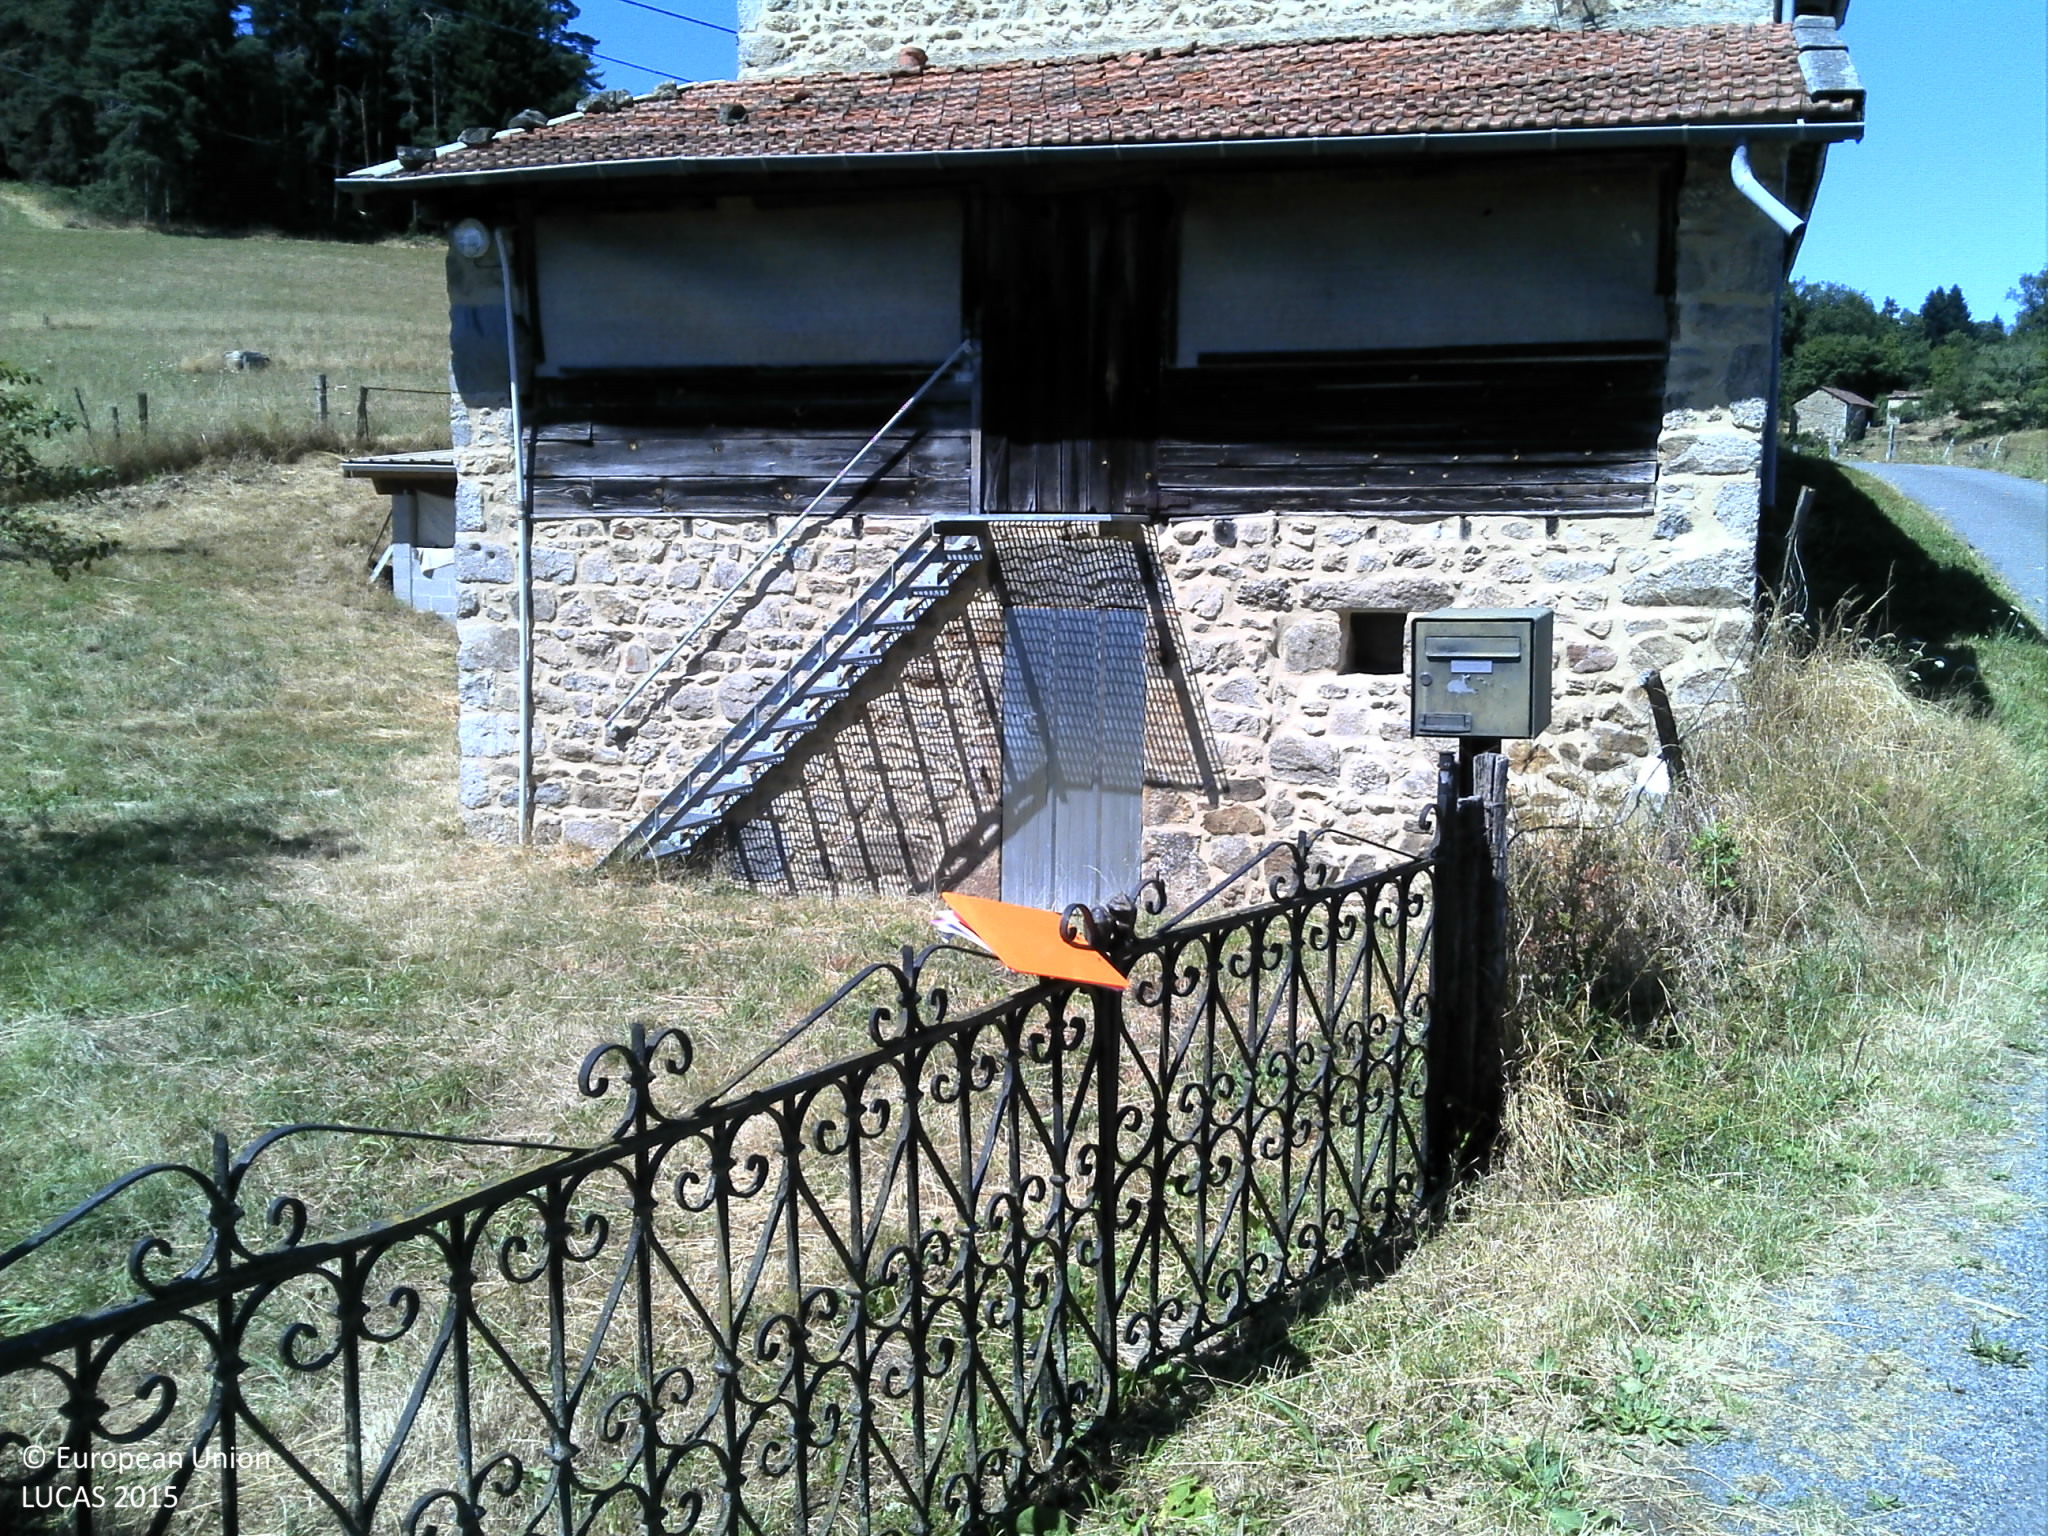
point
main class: Grassland
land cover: Grassland without tree/shrub cover
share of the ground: > 75 %
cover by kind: herbaceous plants 100 %
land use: Residential
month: July
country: FR
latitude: 45.6237
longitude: 3.7045
